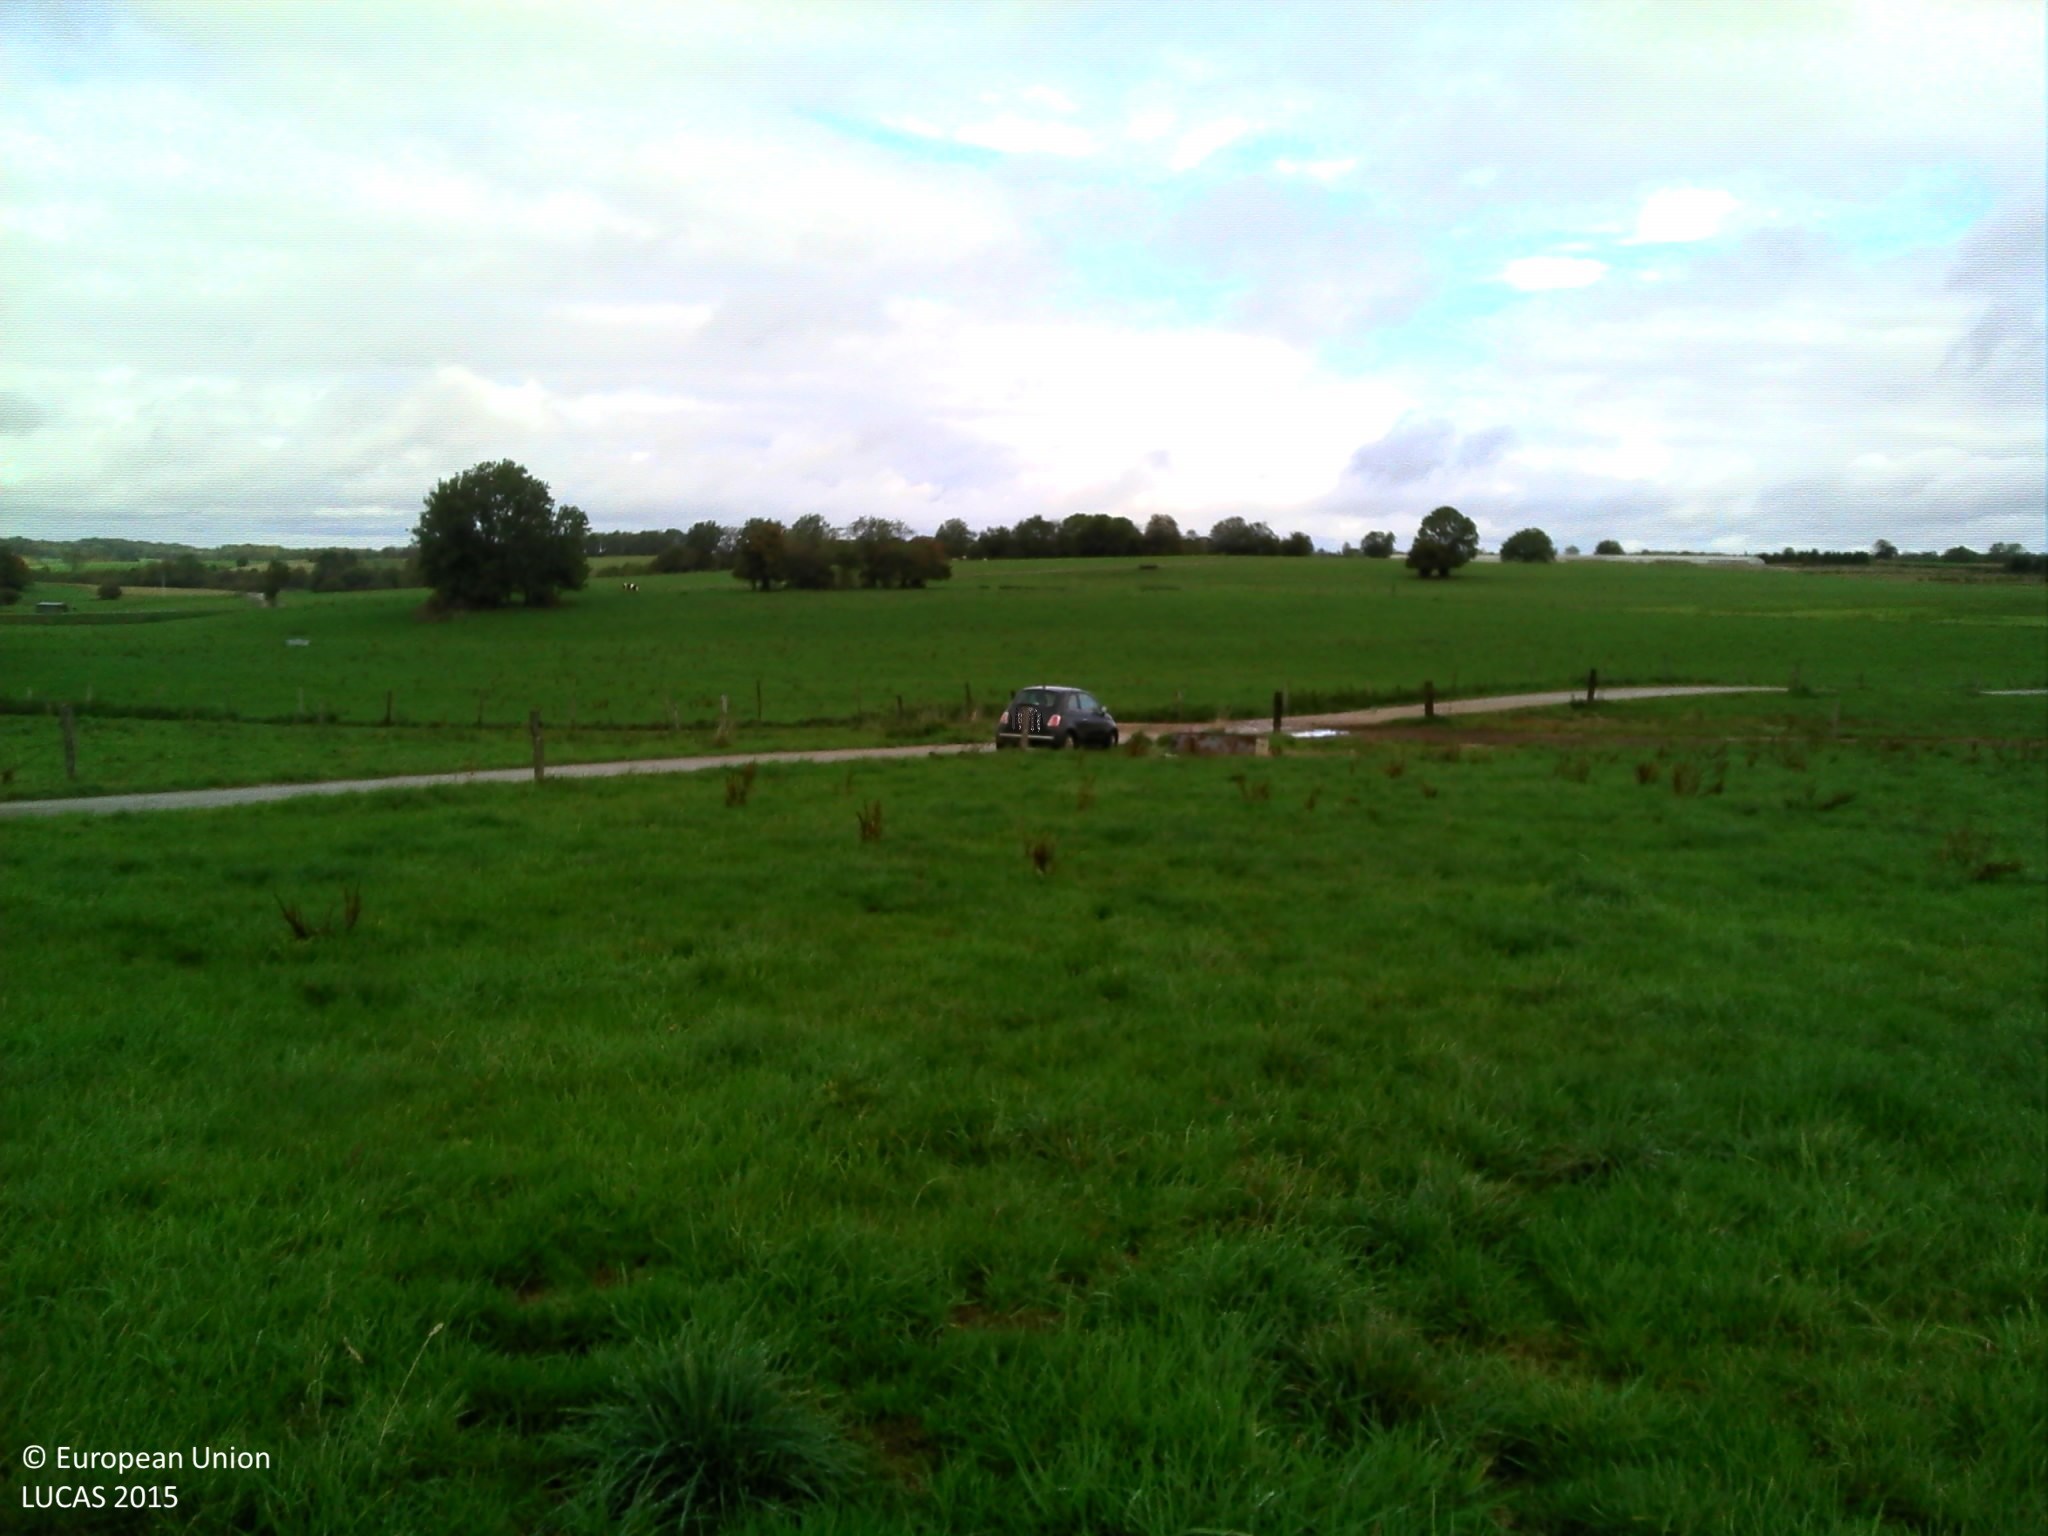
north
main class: Grassland
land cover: Grassland without tree/shrub cover
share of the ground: > 75 %
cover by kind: herbaceous plants 100 %
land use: Agriculture (excluding fallow land and kitchen gardens)
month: October
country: FR
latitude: 47.0201
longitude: 6.1211
